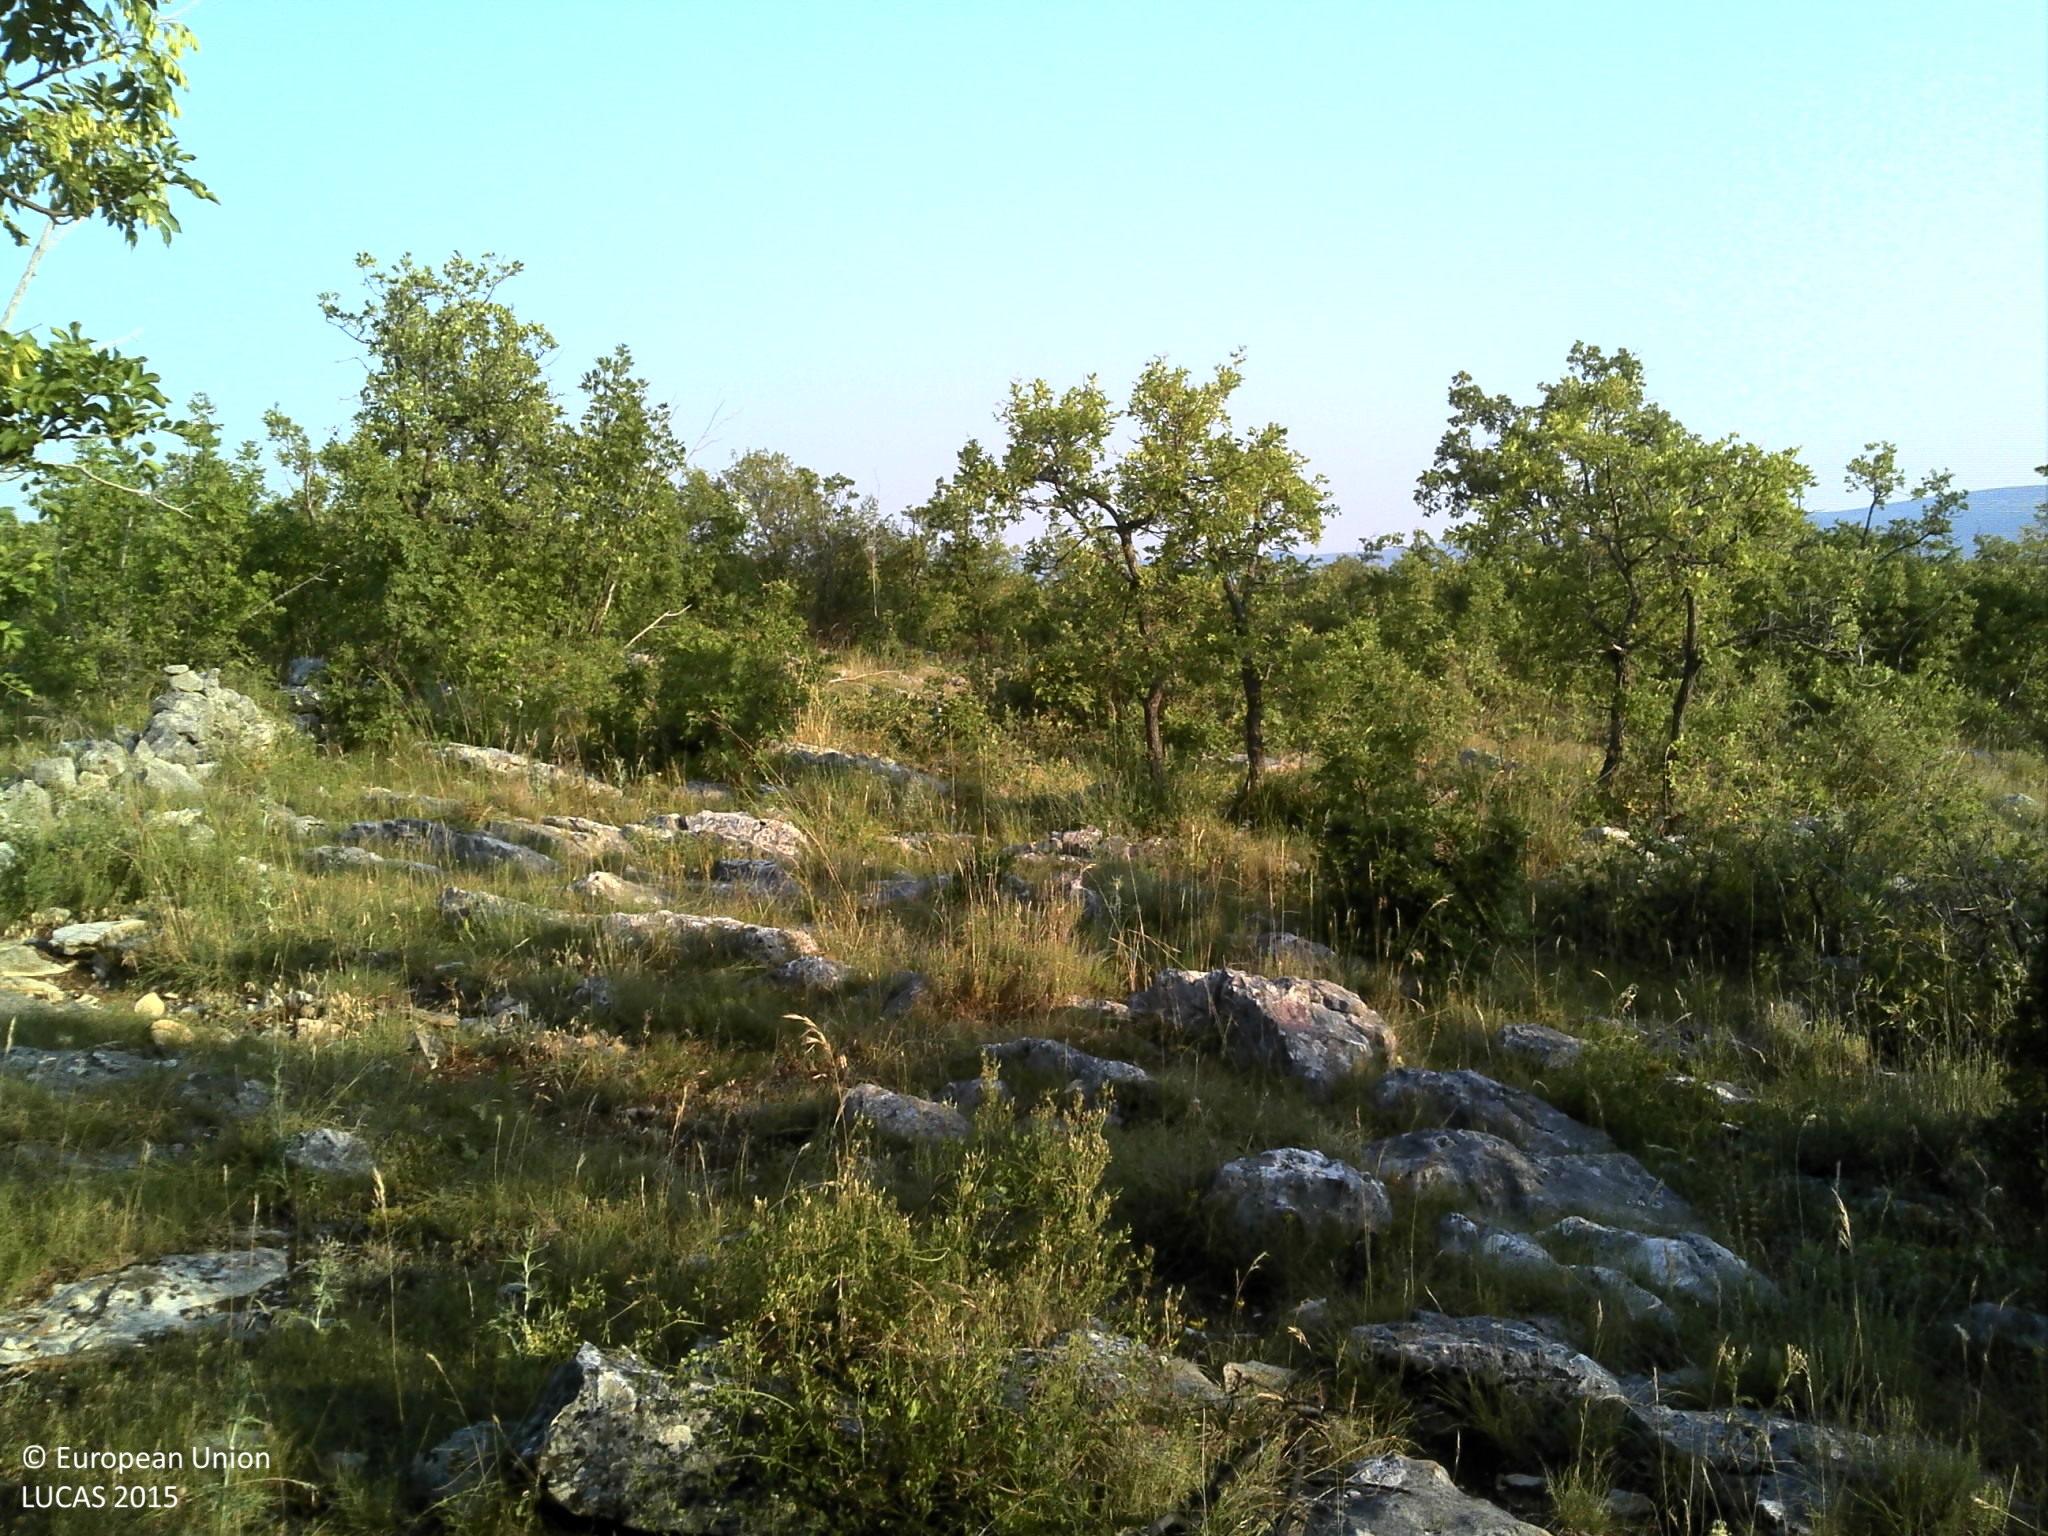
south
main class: Woodland
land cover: Broadleaved woodland
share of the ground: 10 - 25 %
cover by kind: shrubs 30 %, broadleaved forest trees 25 %, unconsolidated bare surface 25 %, herbaceous plants 20 %
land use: Semi-natural and natural areas not in use
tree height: > 5 m
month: July
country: HR
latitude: 43.8891
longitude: 16.2782
